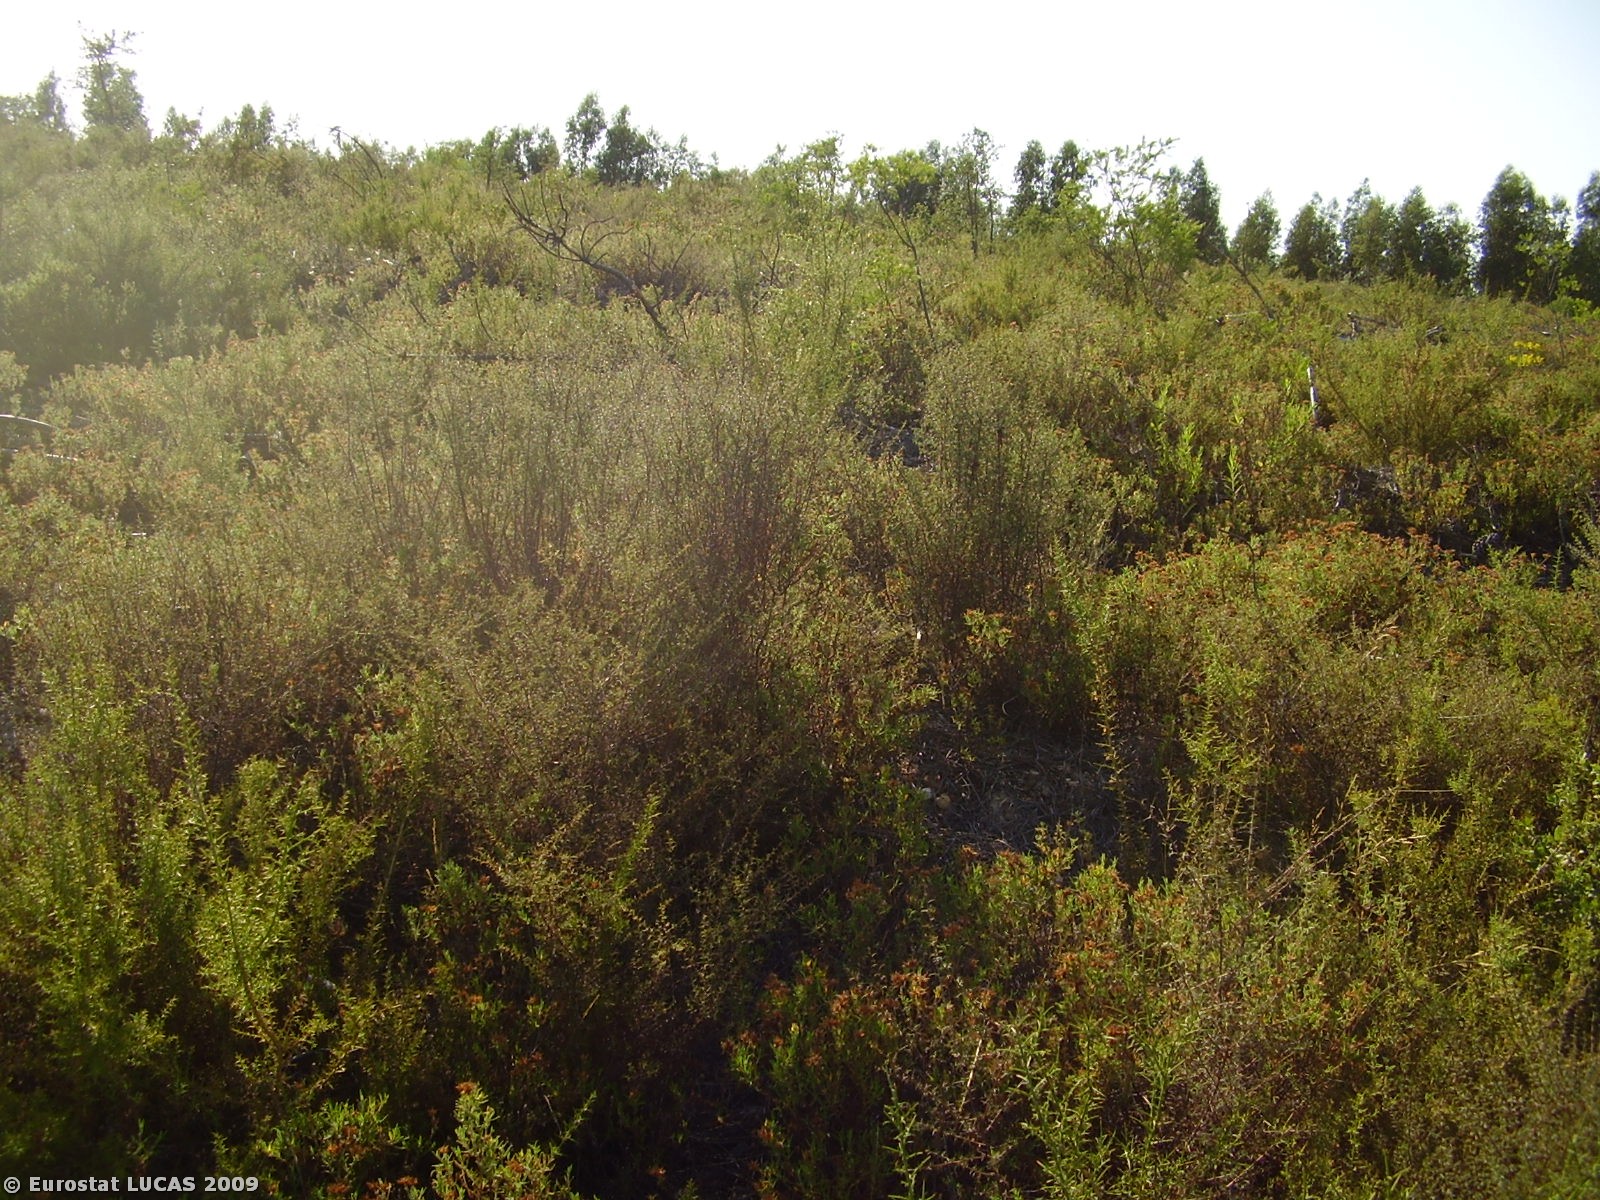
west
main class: Shrubland
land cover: Shrubland with sparse tree cover
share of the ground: > 75 %
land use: Fallow land
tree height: > 5 m
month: July
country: PT
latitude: 39.4403
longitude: -8.0813
